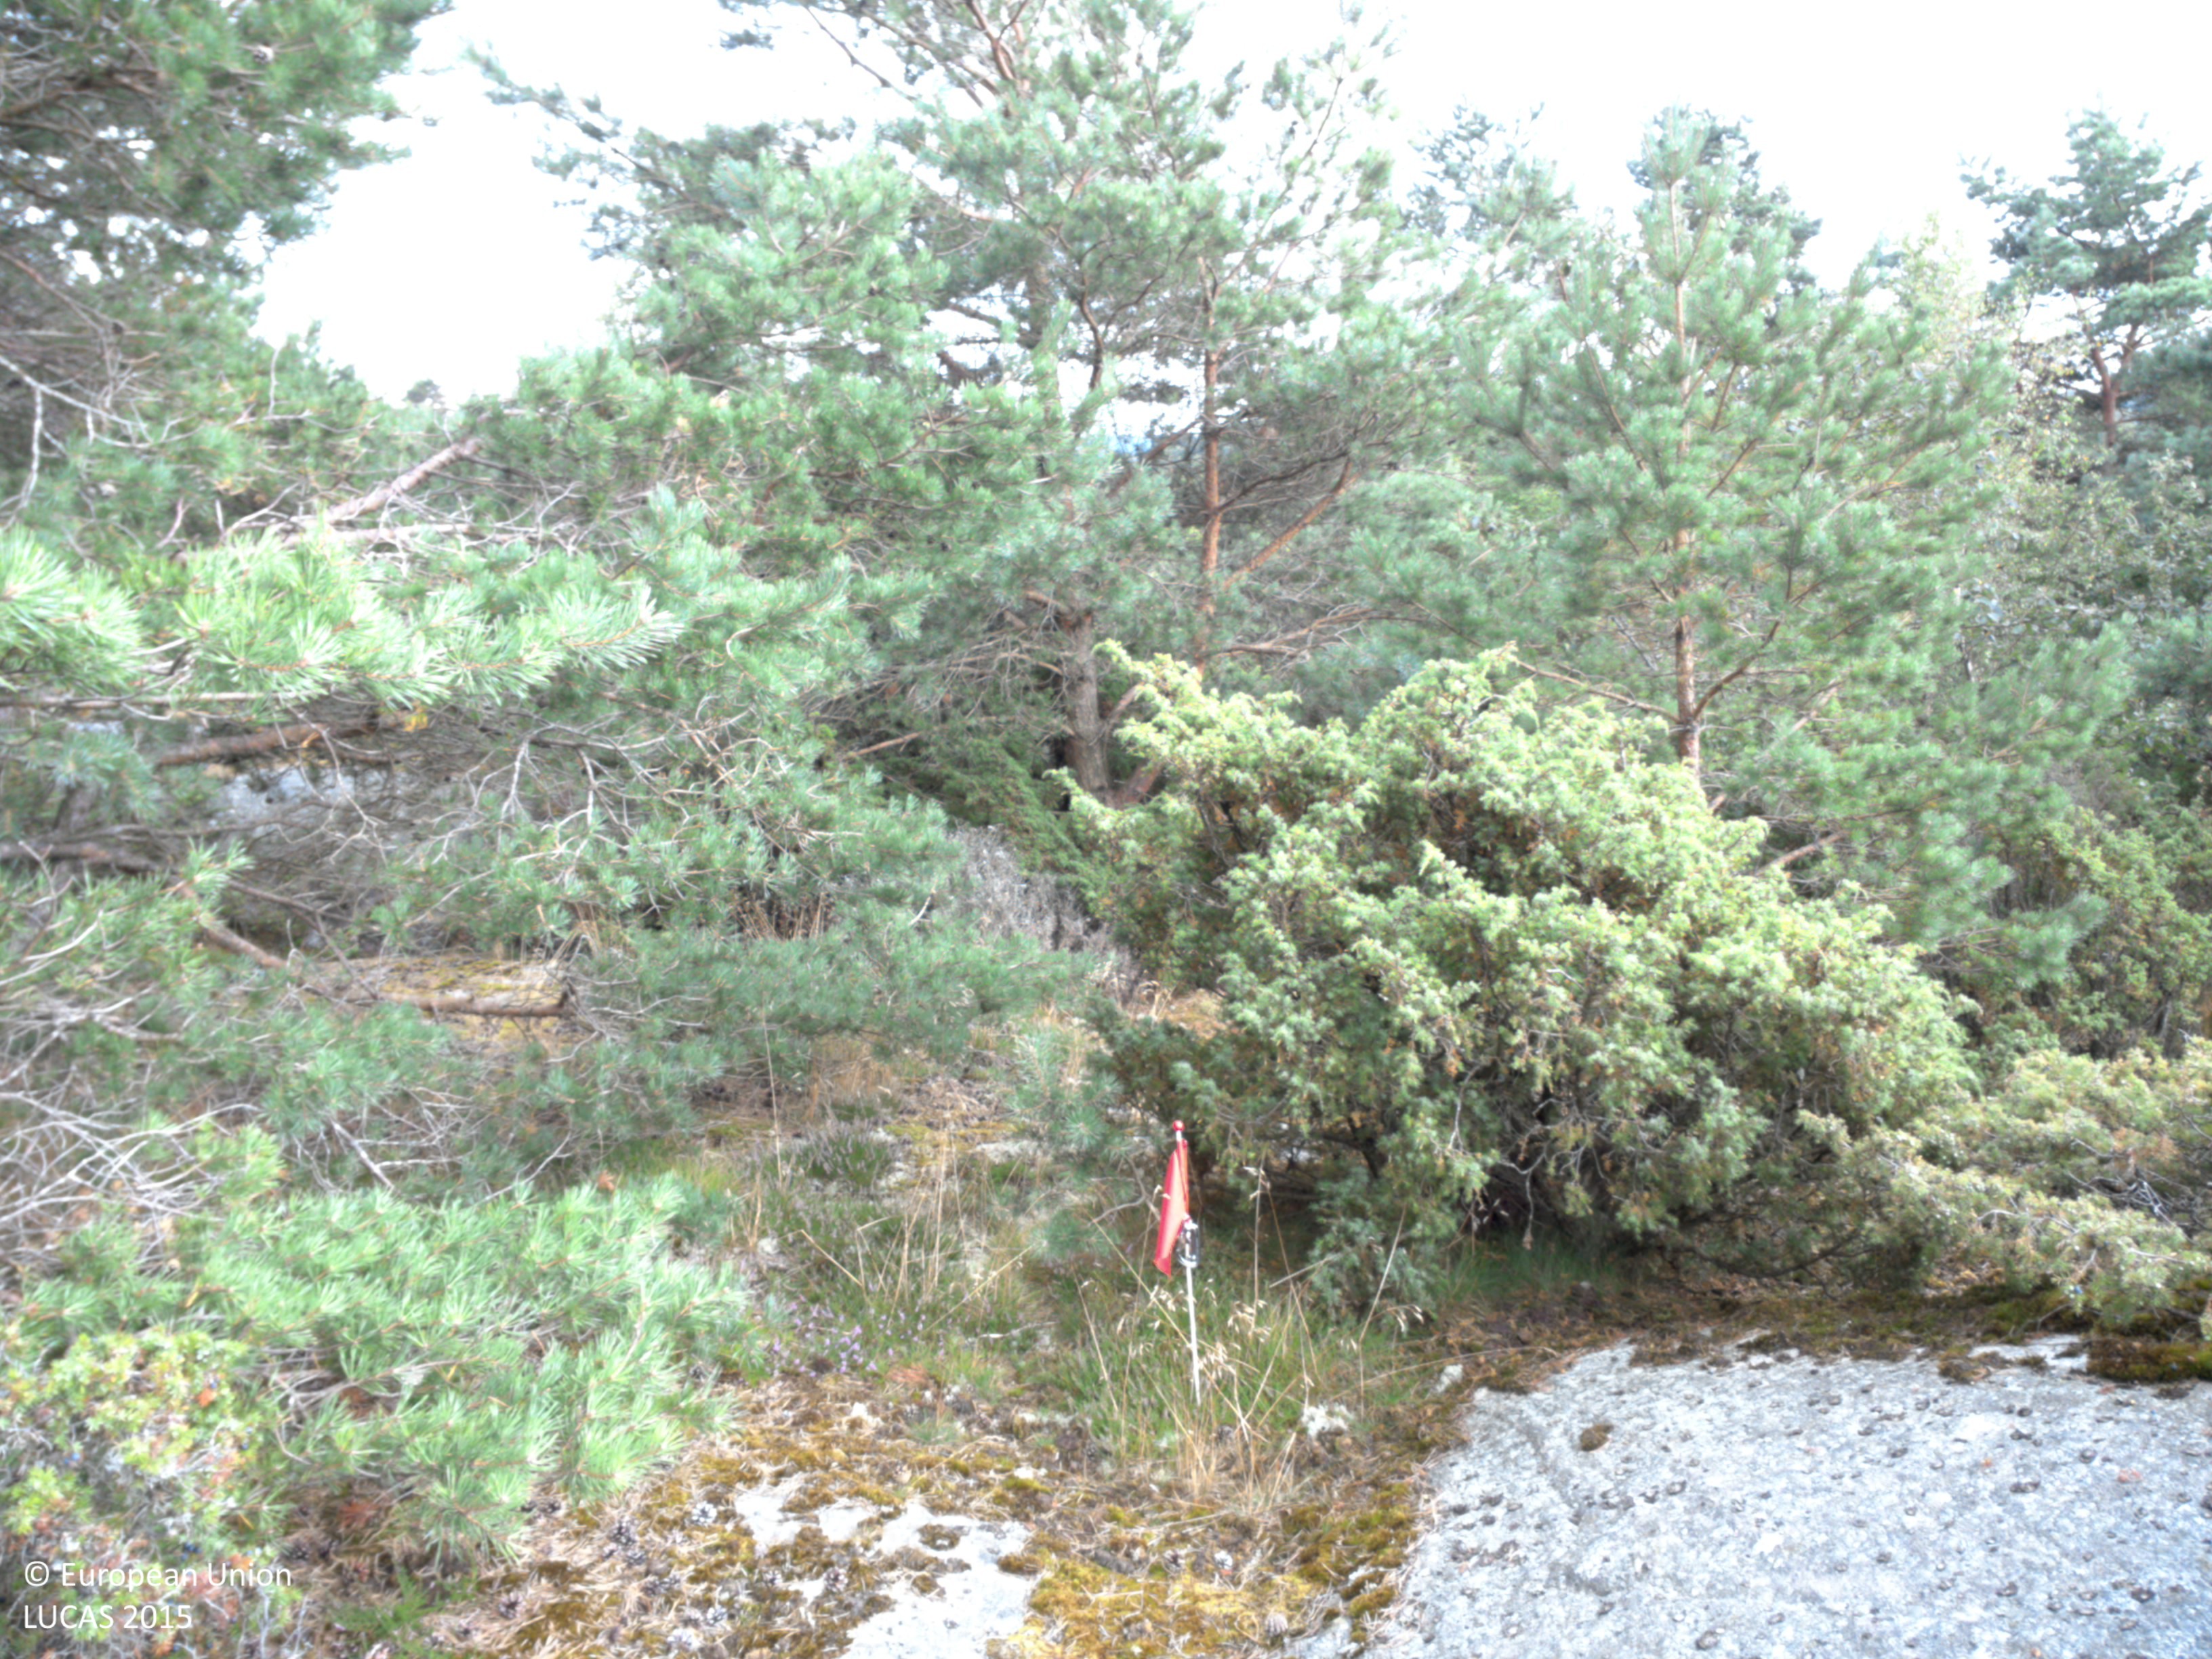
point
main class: Woodland
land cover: Pine dominated coniferous woodland
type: boreal forest
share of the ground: 50 - 75 %
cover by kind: coniferous forest trees 50 %, shrubs 20 %, lichens and mosses 20 %, unconsolidated bare surface 10 %
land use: Forestry
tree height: < 5 m
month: August
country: SE
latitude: 57.9910
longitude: 11.8404
